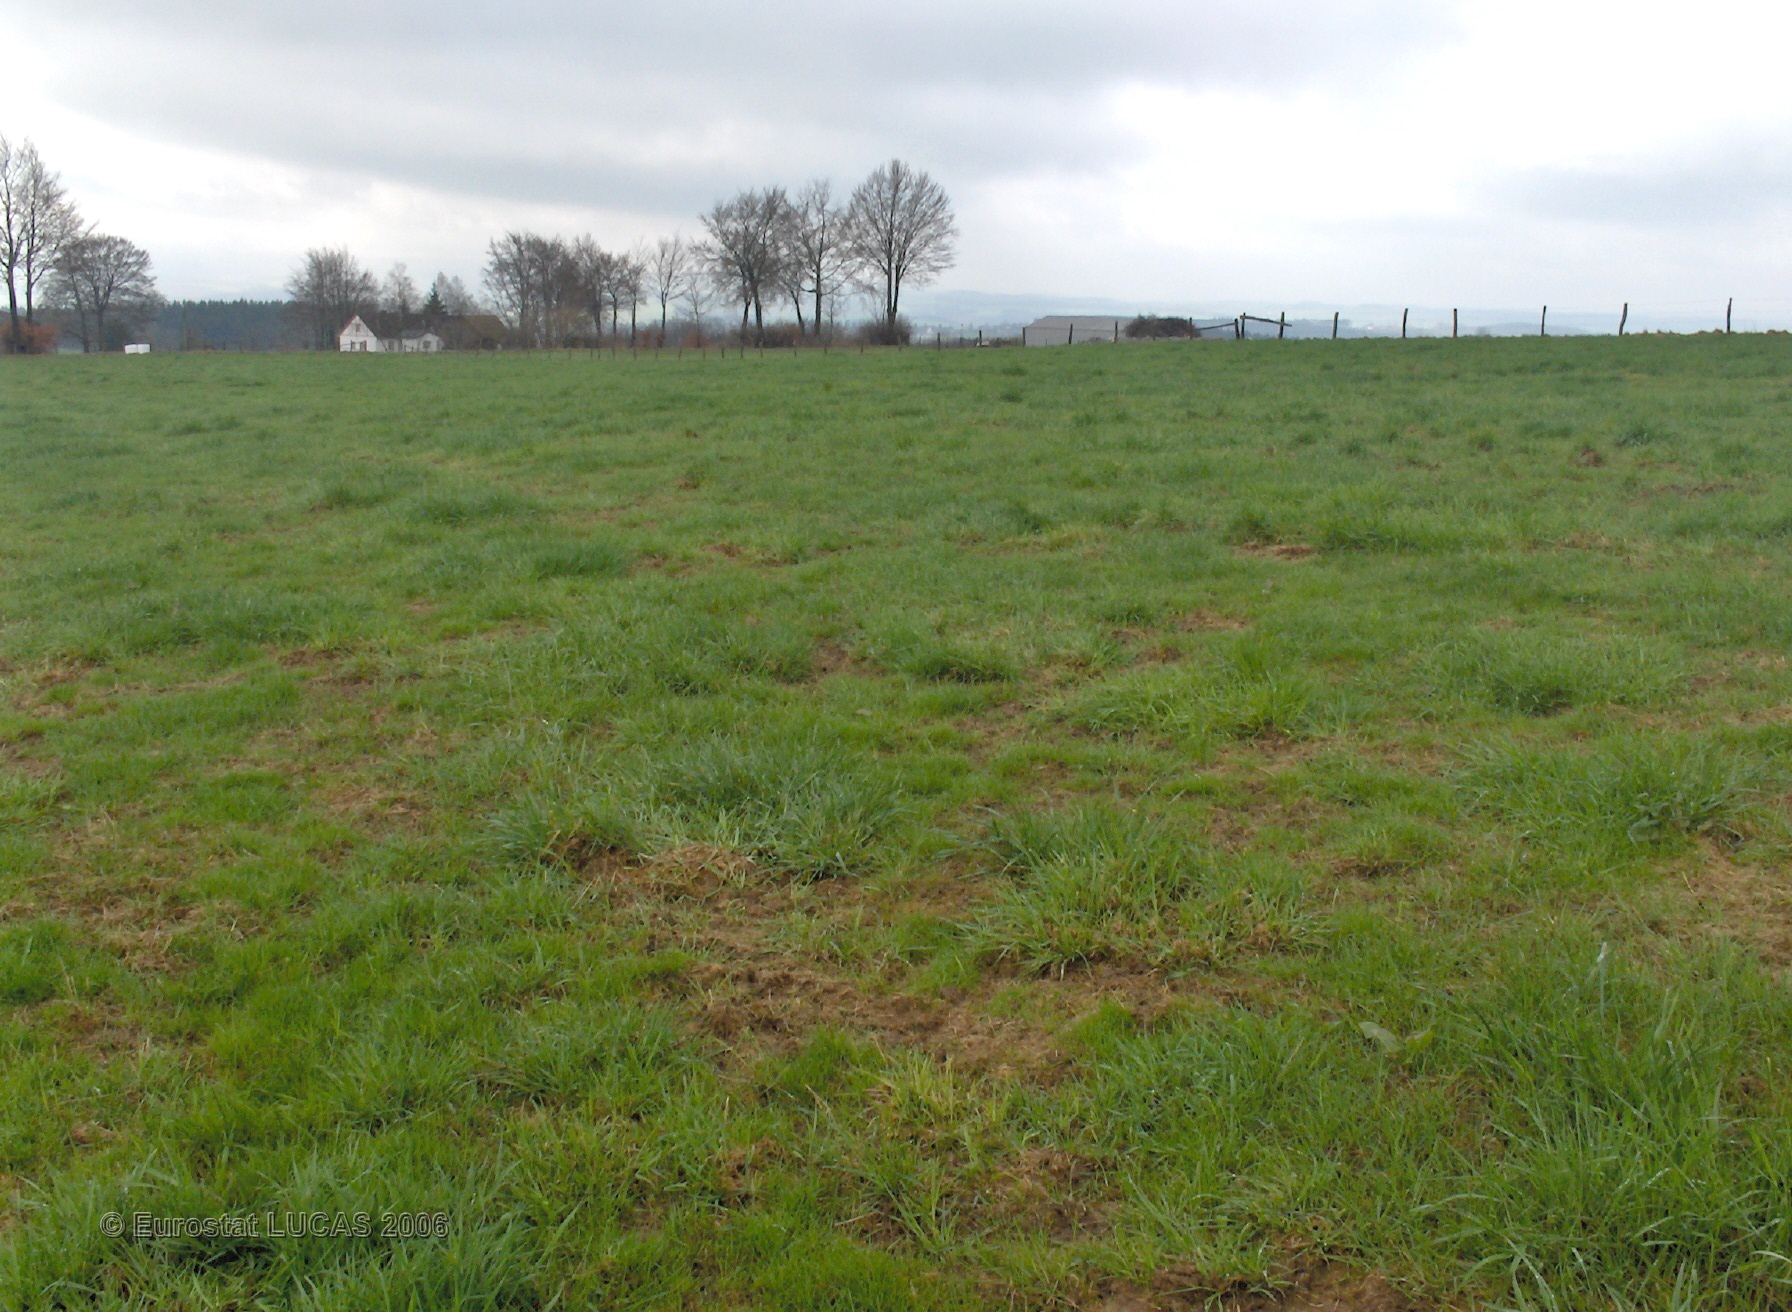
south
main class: Grassland
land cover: Grassland without tree/shrub cover
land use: Agriculture (excluding fallow land and kitchen gardens)
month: May
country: BE
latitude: 50.3592
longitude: 6.3307
